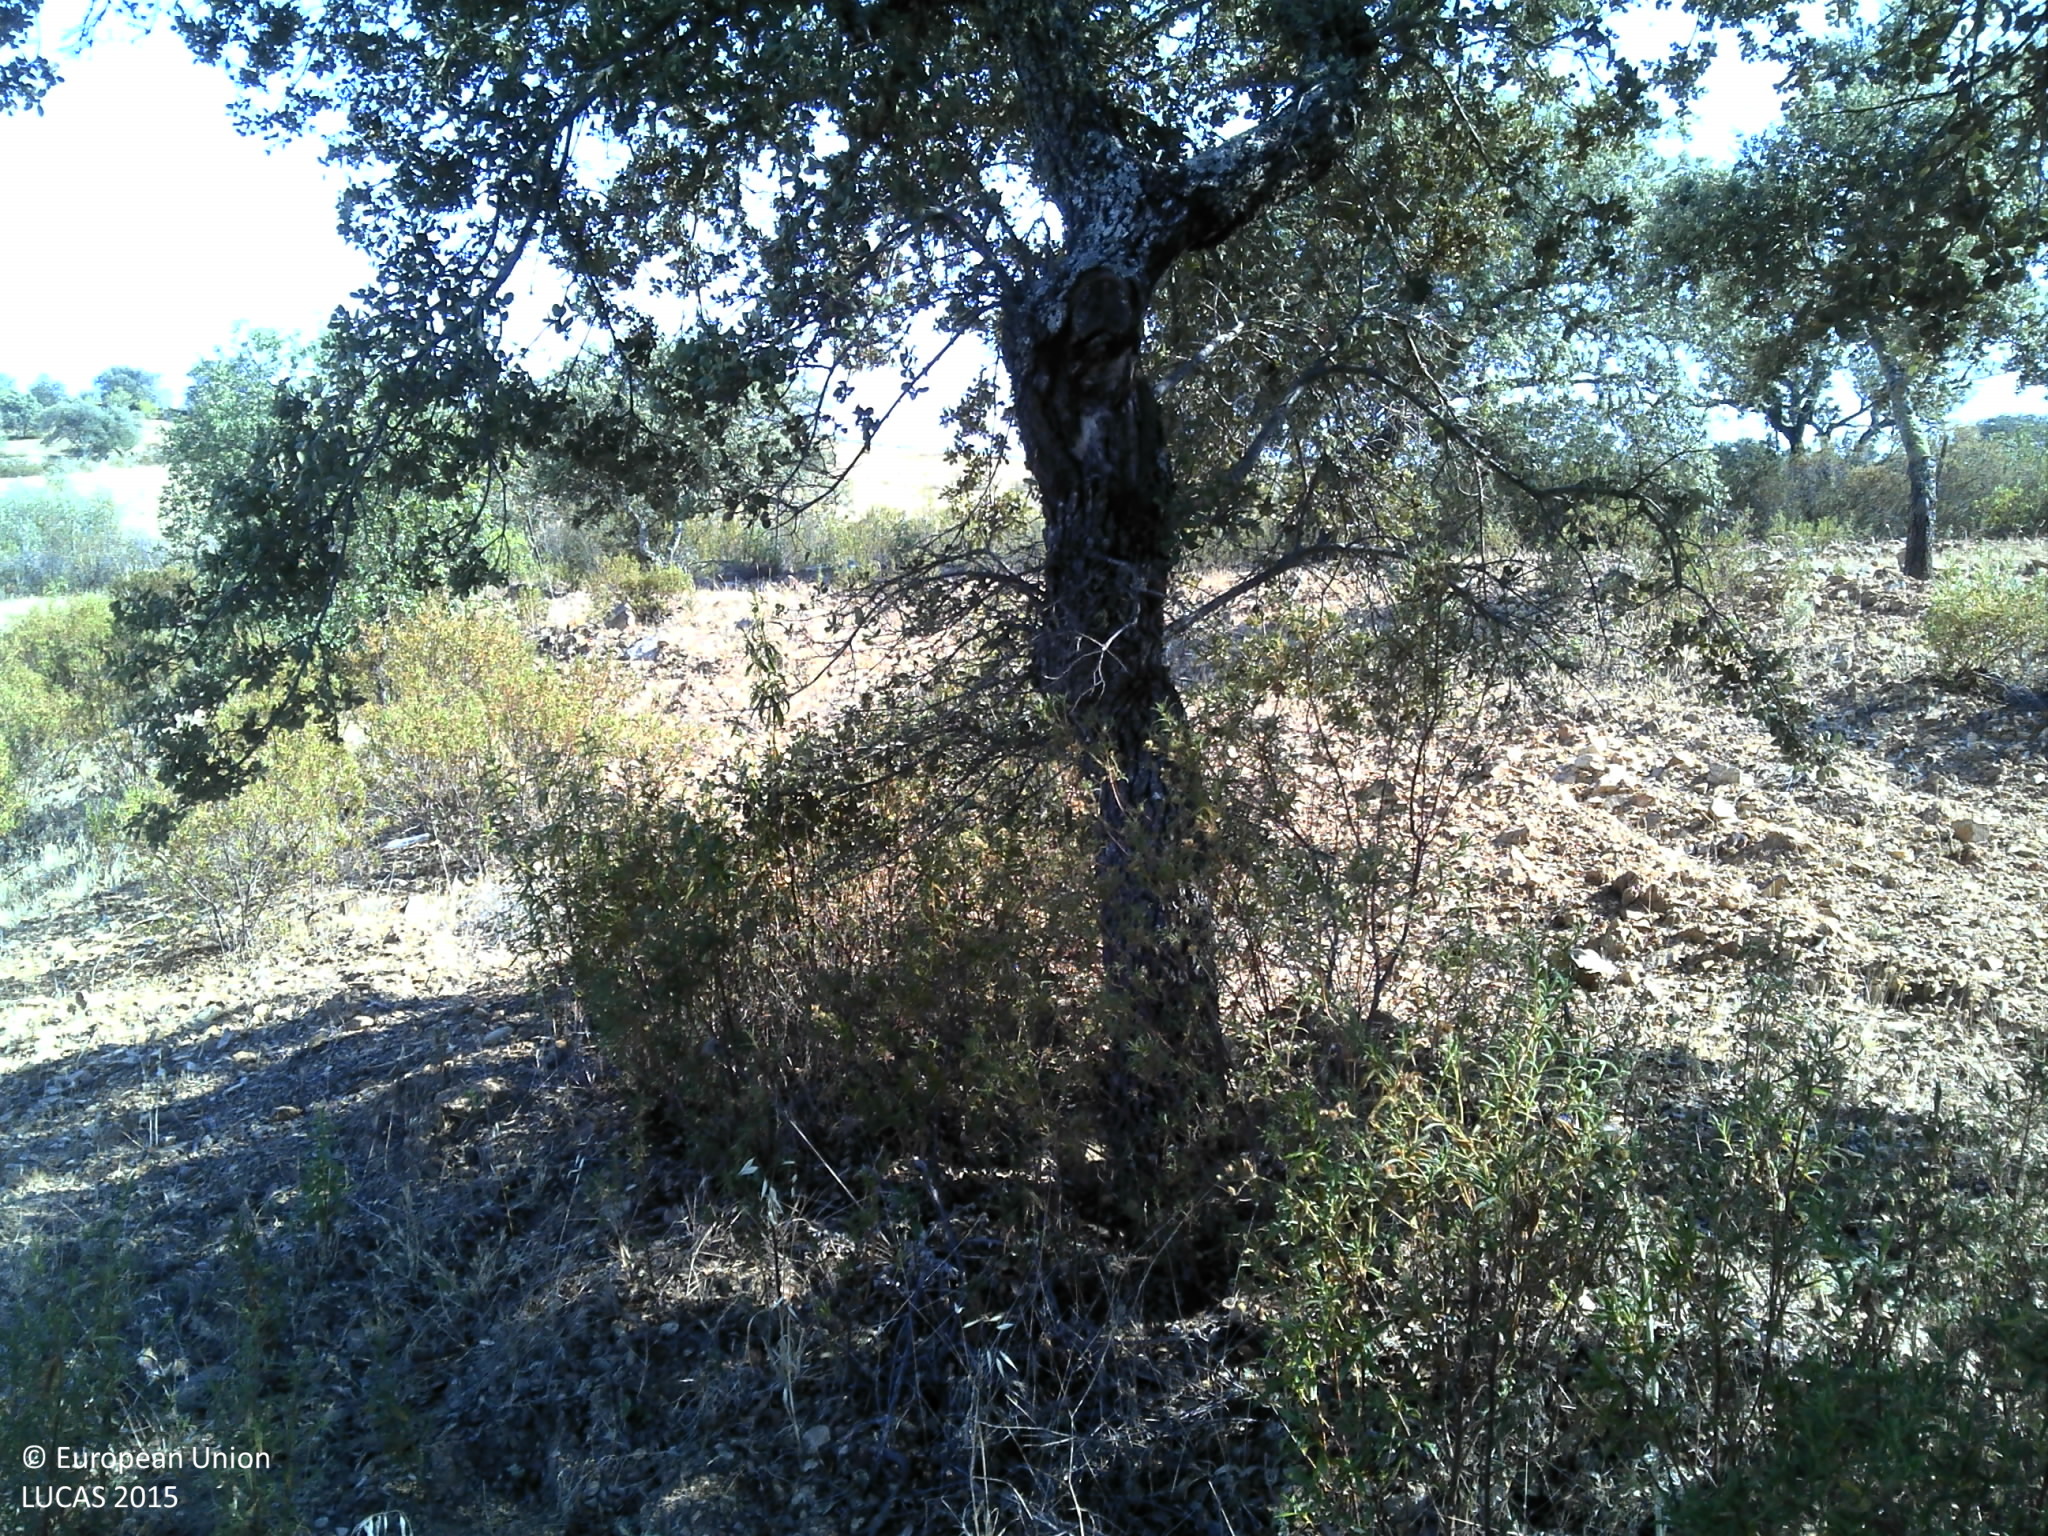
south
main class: Woodland
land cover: Broadleaved woodland
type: broadleaved evergreen forest
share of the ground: 25 - 50 %
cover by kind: broadleaved forest trees 35 %, herbaceous plants 30 %, unconsolidated bare surface 30 %, shrubs 5 %
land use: Forestry
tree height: > 5 m
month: June
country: PT
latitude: 37.4695
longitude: -7.8473
